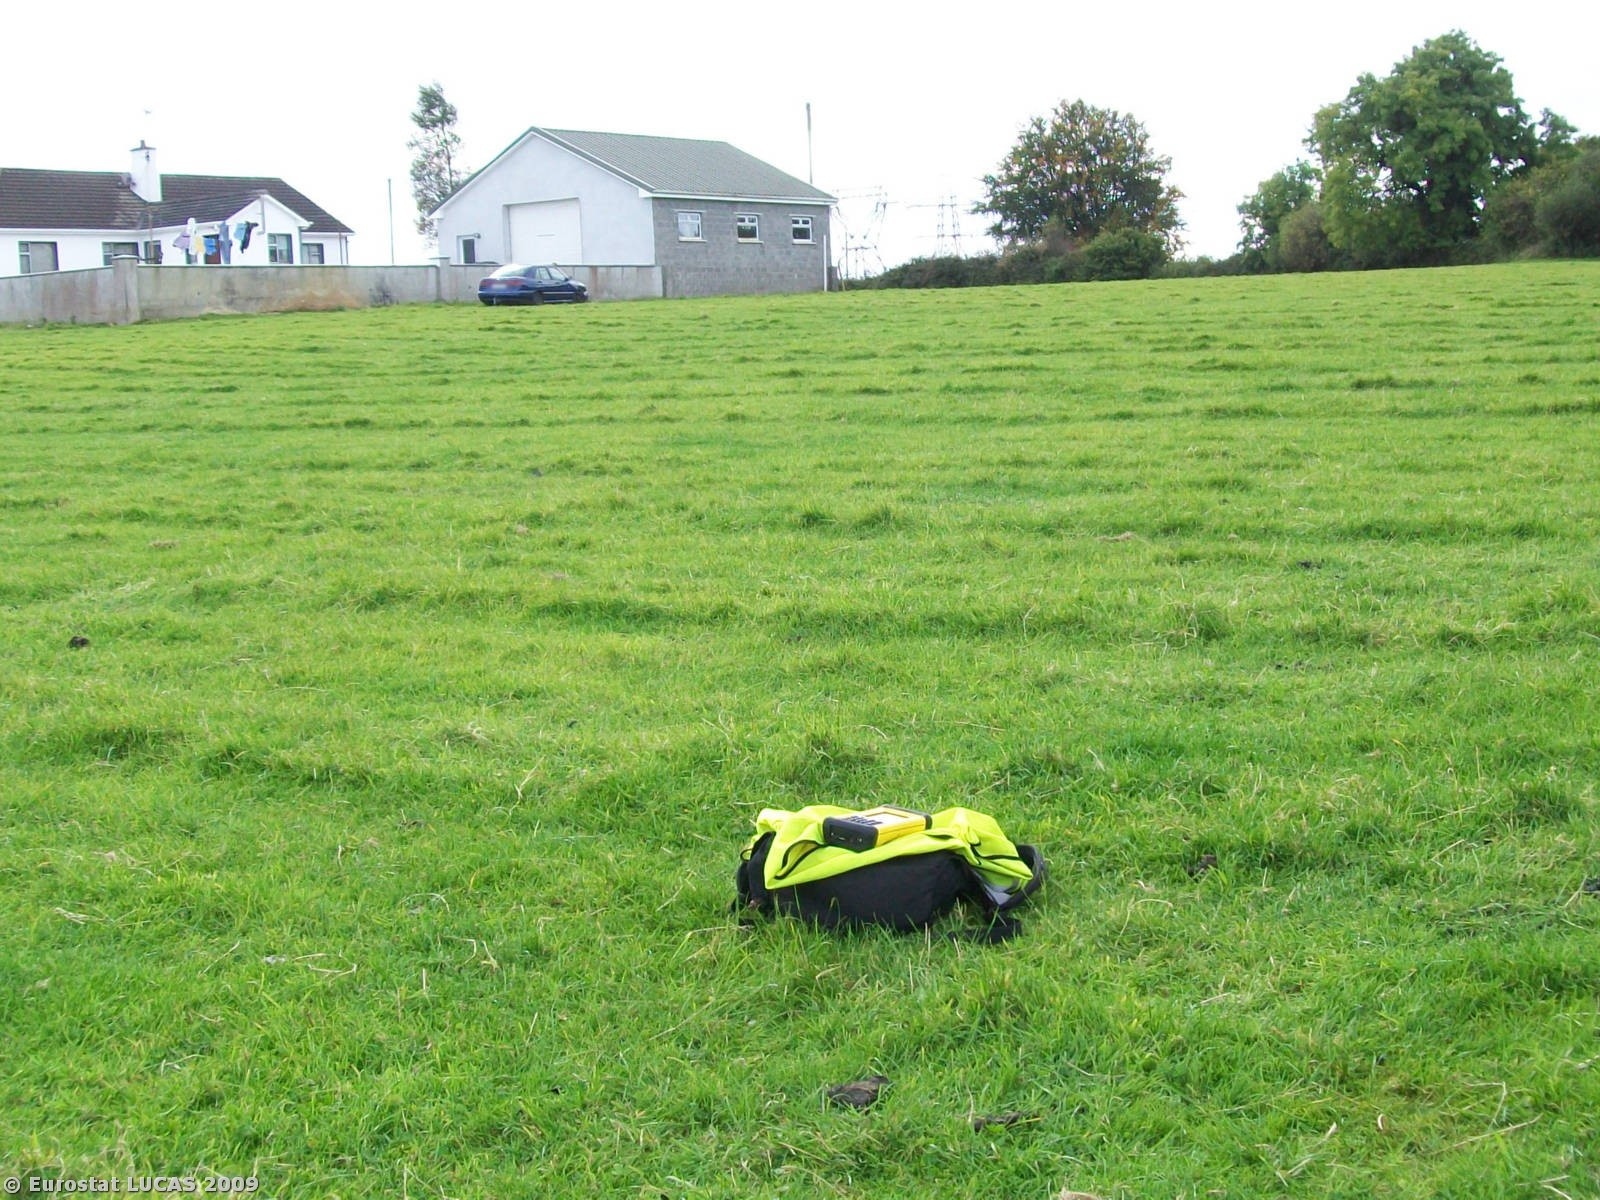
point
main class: Grassland
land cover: Grassland without tree/shrub cover
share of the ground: > 75 %
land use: Agriculture (excluding fallow land and kitchen gardens)
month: September
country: IE
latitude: 53.1793
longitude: -8.3684
